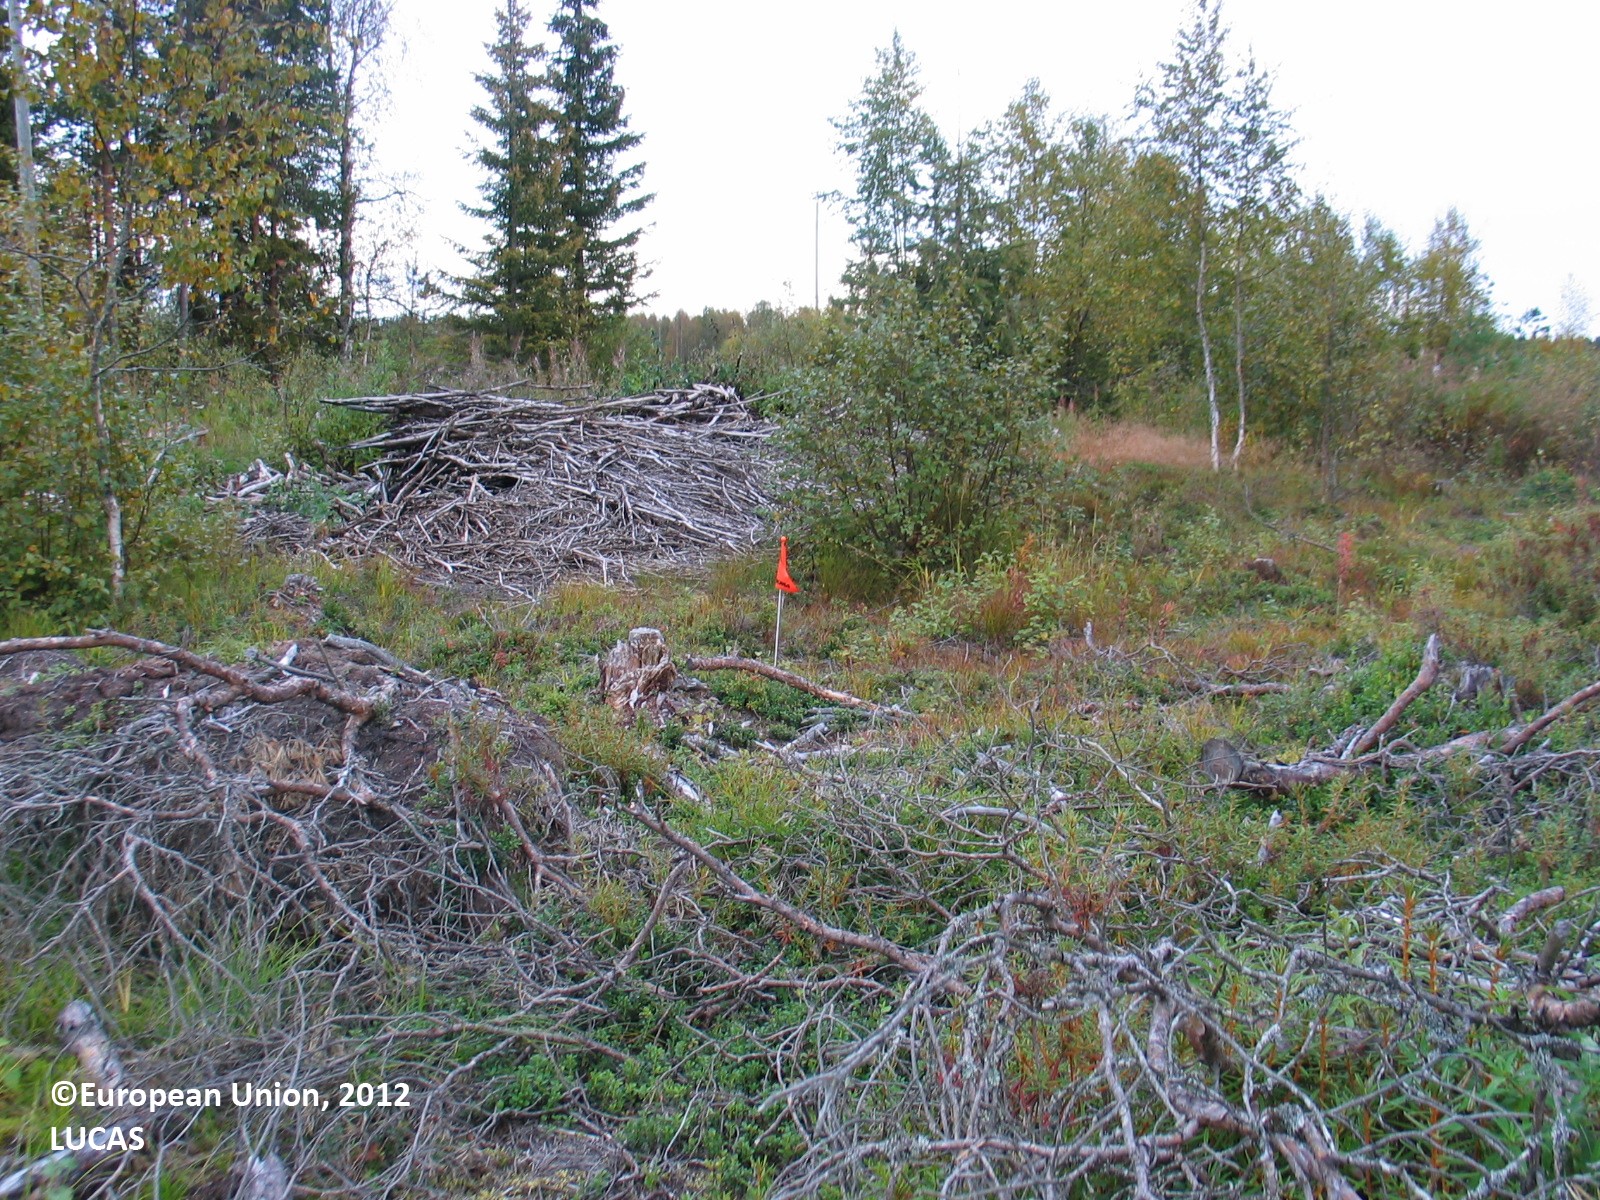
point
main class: Shrubland
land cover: Shrubland with sparse tree cover
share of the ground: 50 - 75 %
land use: Forestry
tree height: < 5 m
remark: Clear cut
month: September
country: FI
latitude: 65.3123
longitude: 25.5079
